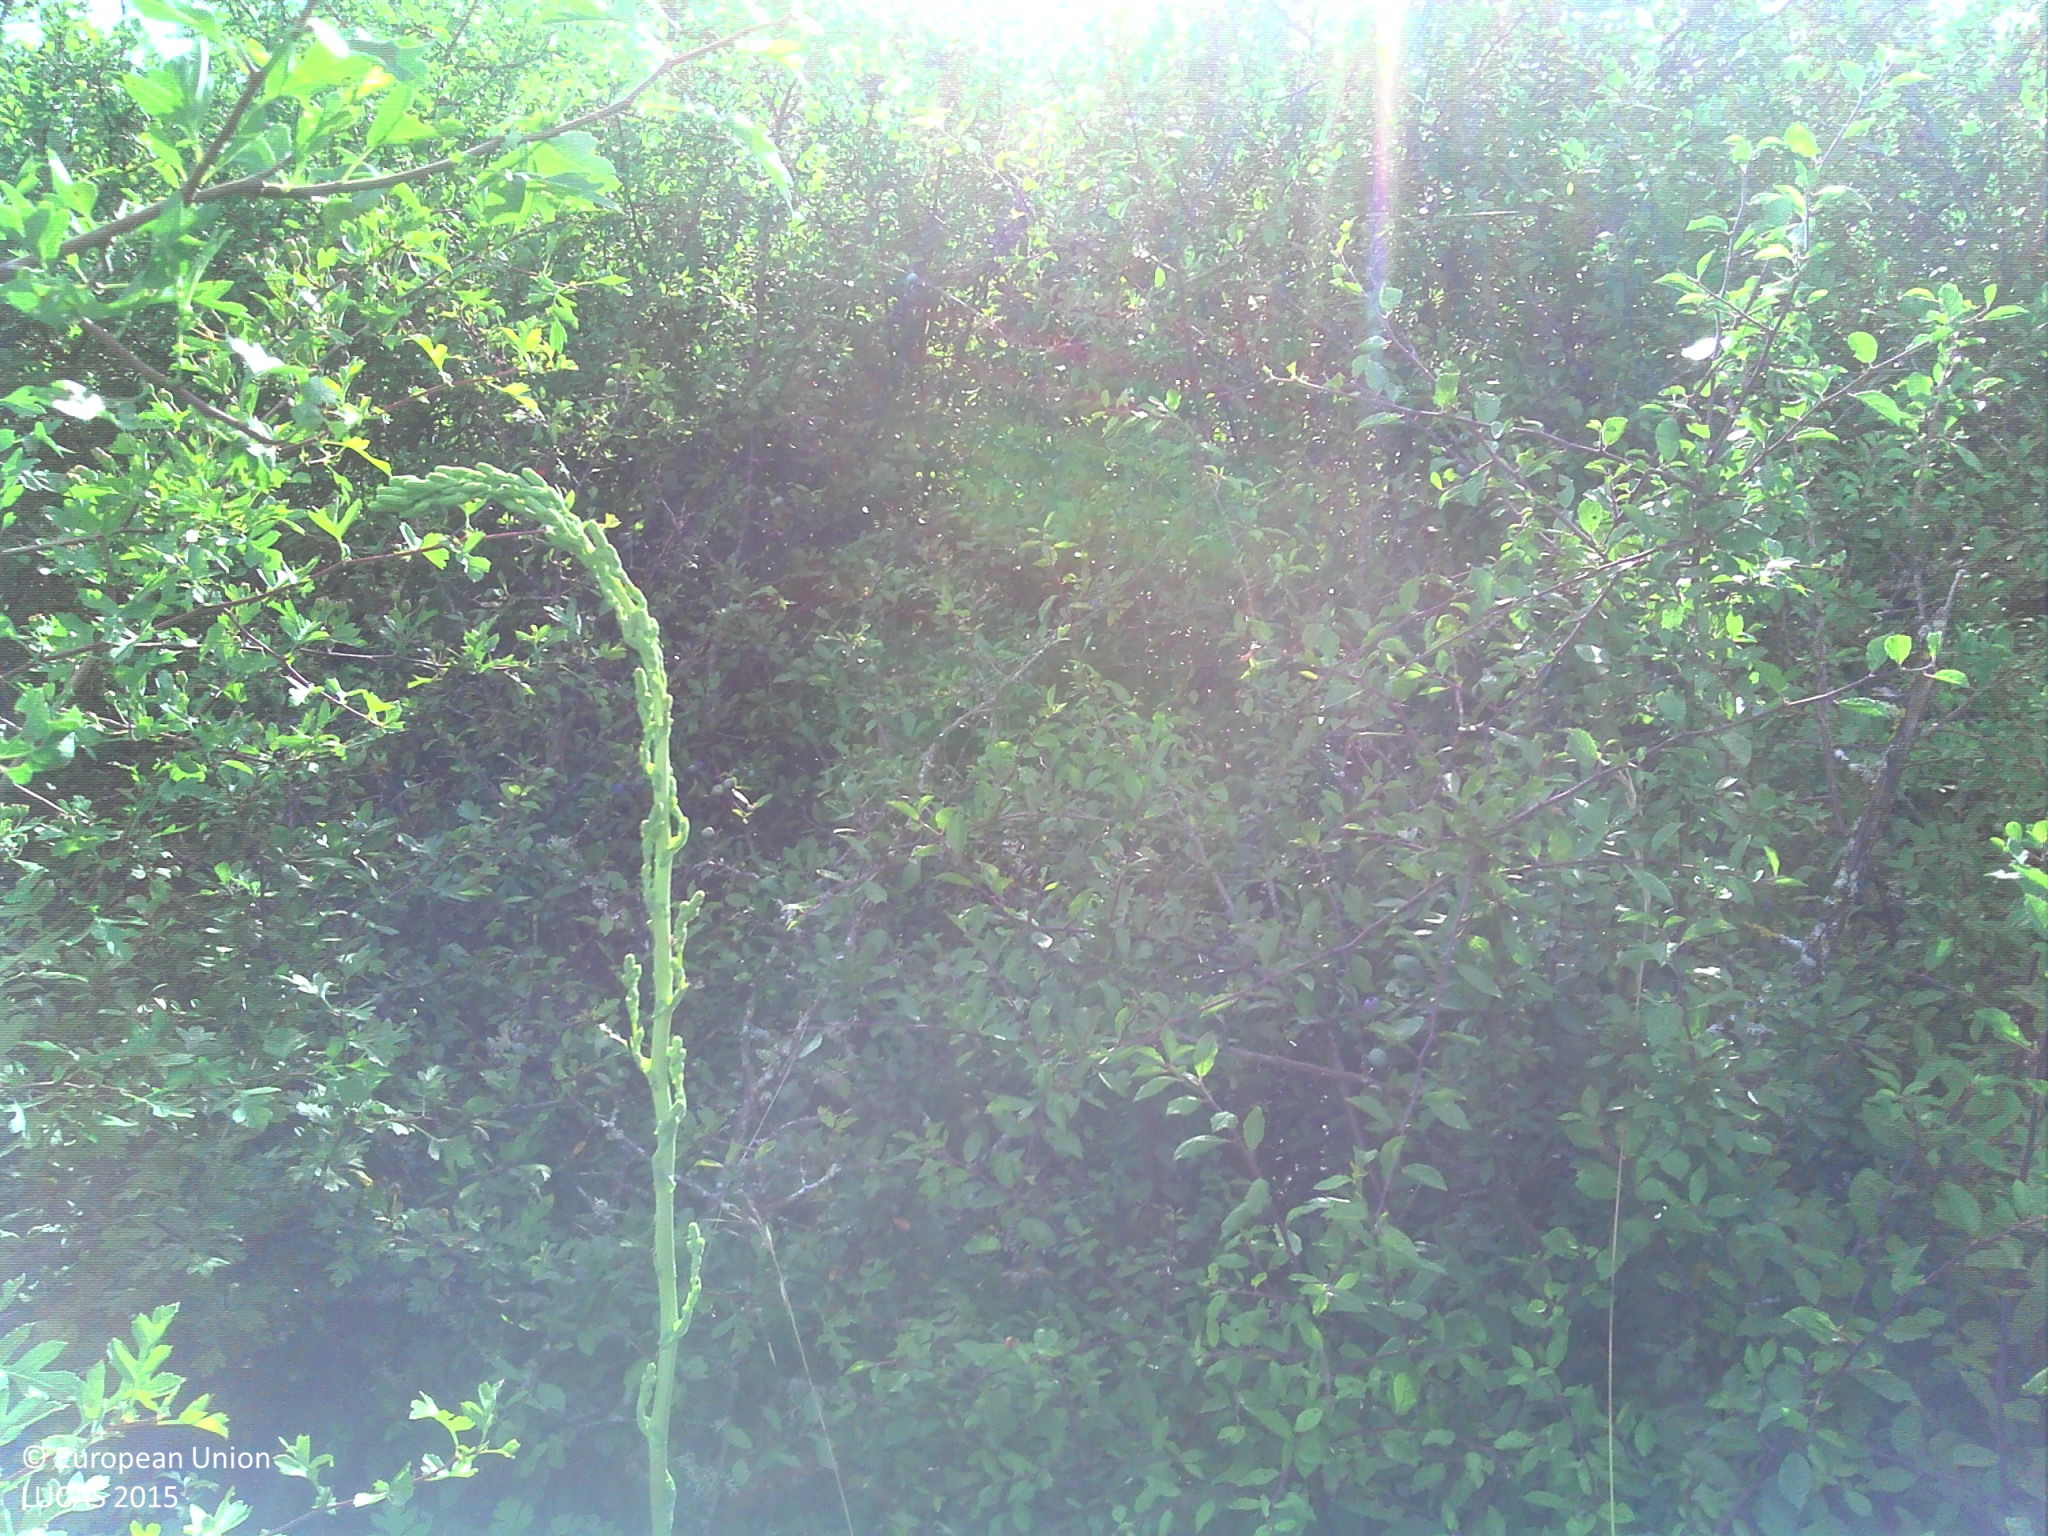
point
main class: Shrubland
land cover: Shrubland with sparse tree cover
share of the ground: > 75 %
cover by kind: shrubs 95 %, broadleaved forest trees 5 %
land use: Abandoned areas
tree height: < 5 m
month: June
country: FR
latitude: 44.0896
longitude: 1.9213
